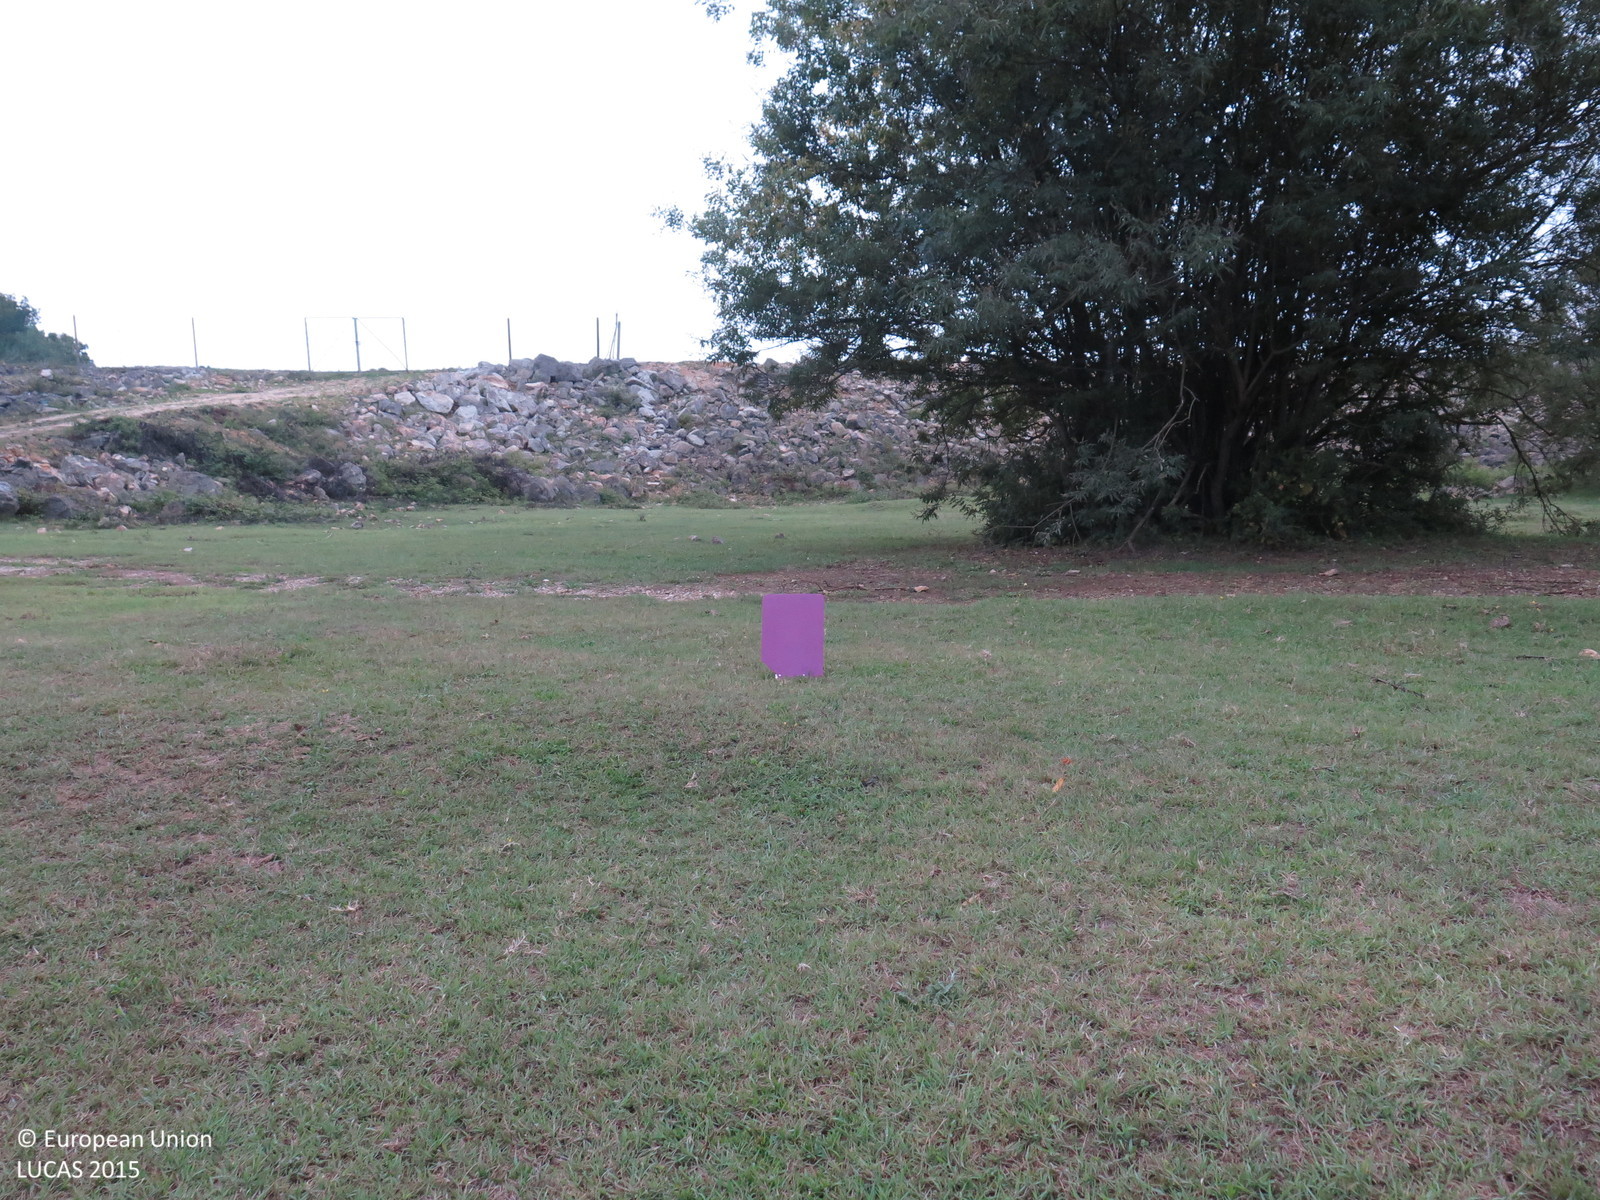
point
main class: Grassland
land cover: Grassland with sparse tree/shrub cover
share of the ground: > 75 %
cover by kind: herbaceous plants 95 %, broadleaved forest trees 5 %
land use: Water supply and treatment
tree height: > 5 m
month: August
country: HR
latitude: 45.0812
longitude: 14.5551
